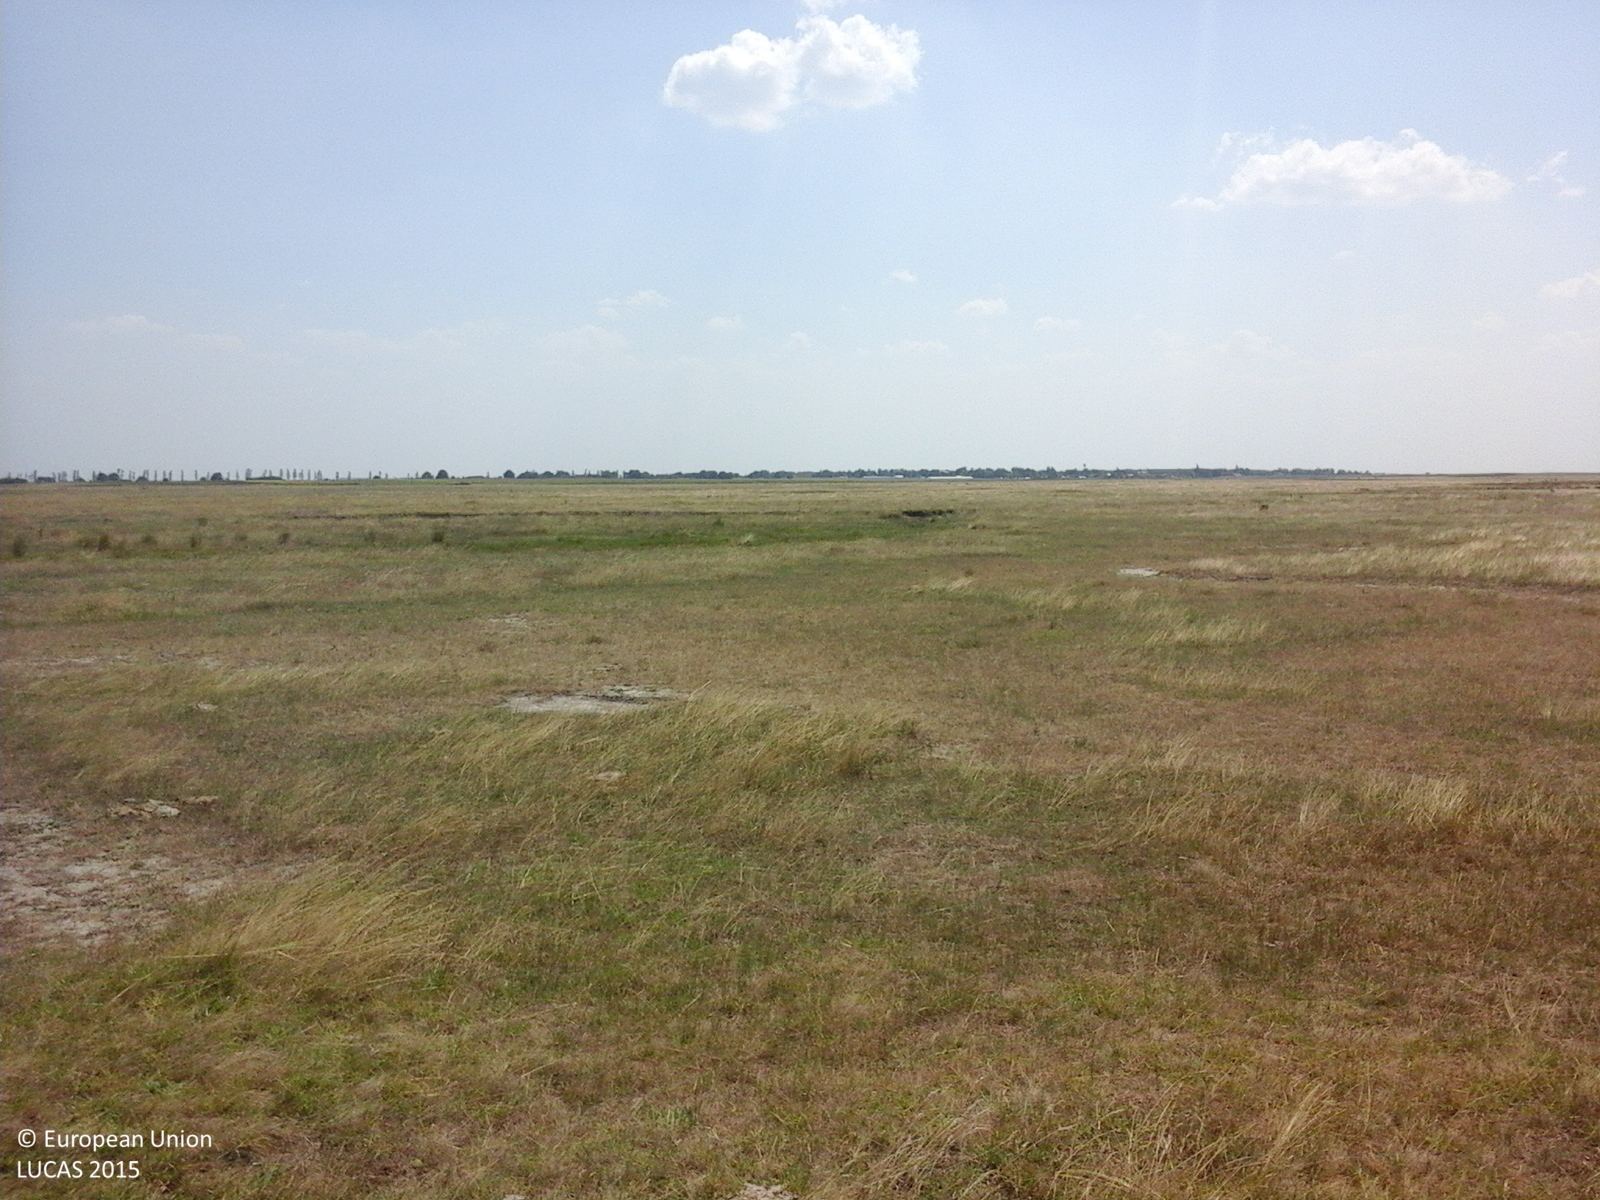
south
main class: Grassland
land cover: Grassland without tree/shrub cover
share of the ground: > 75 %
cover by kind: herbaceous plants 100 %
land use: Agriculture (excluding fallow land and kitchen gardens)
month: August
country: RO
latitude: 45.0106
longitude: 26.6838
